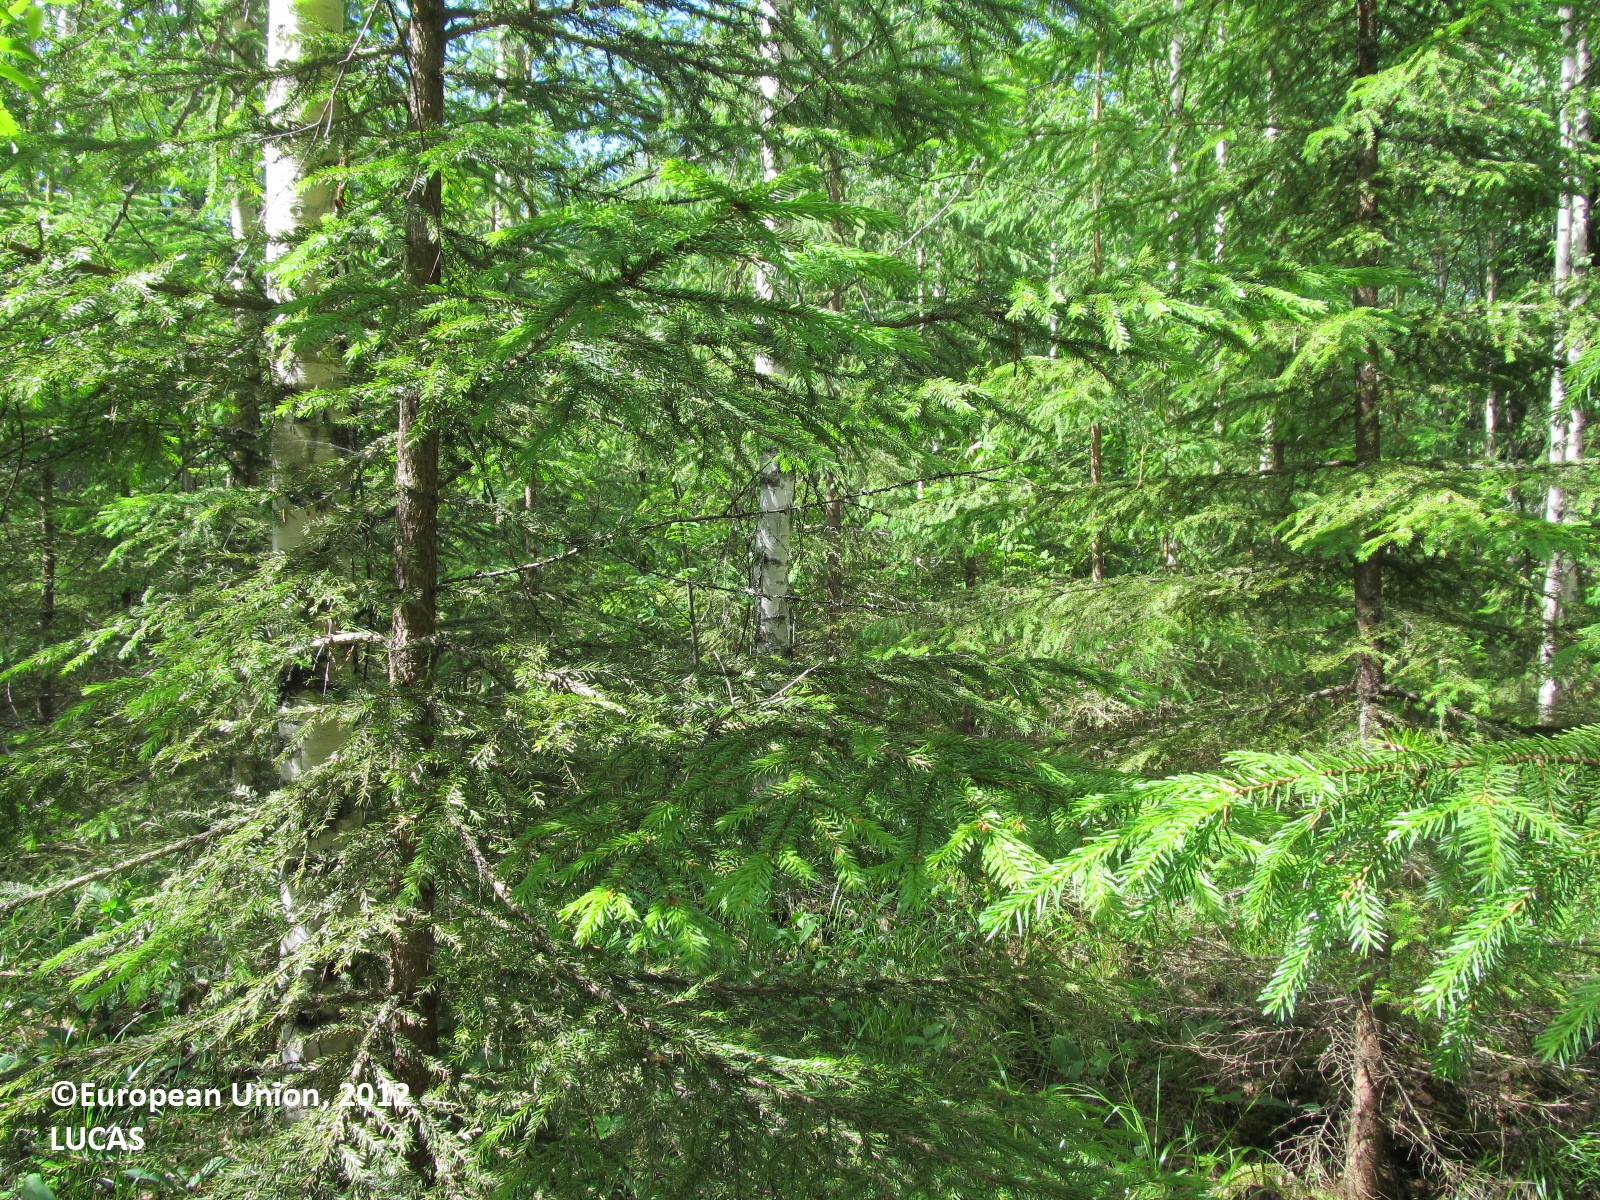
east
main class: Woodland
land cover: Spruce dominated mixed woodland
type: boreal forest
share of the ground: > 75 %
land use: Forestry
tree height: > 5 m
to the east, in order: Spruce dominated mixed woodland; Ditches and canals; Broadleaved woodland; Ditches and canals; Spruce dominated coniferous woodland
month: June
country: FI
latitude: 62.6658
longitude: 28.8954
